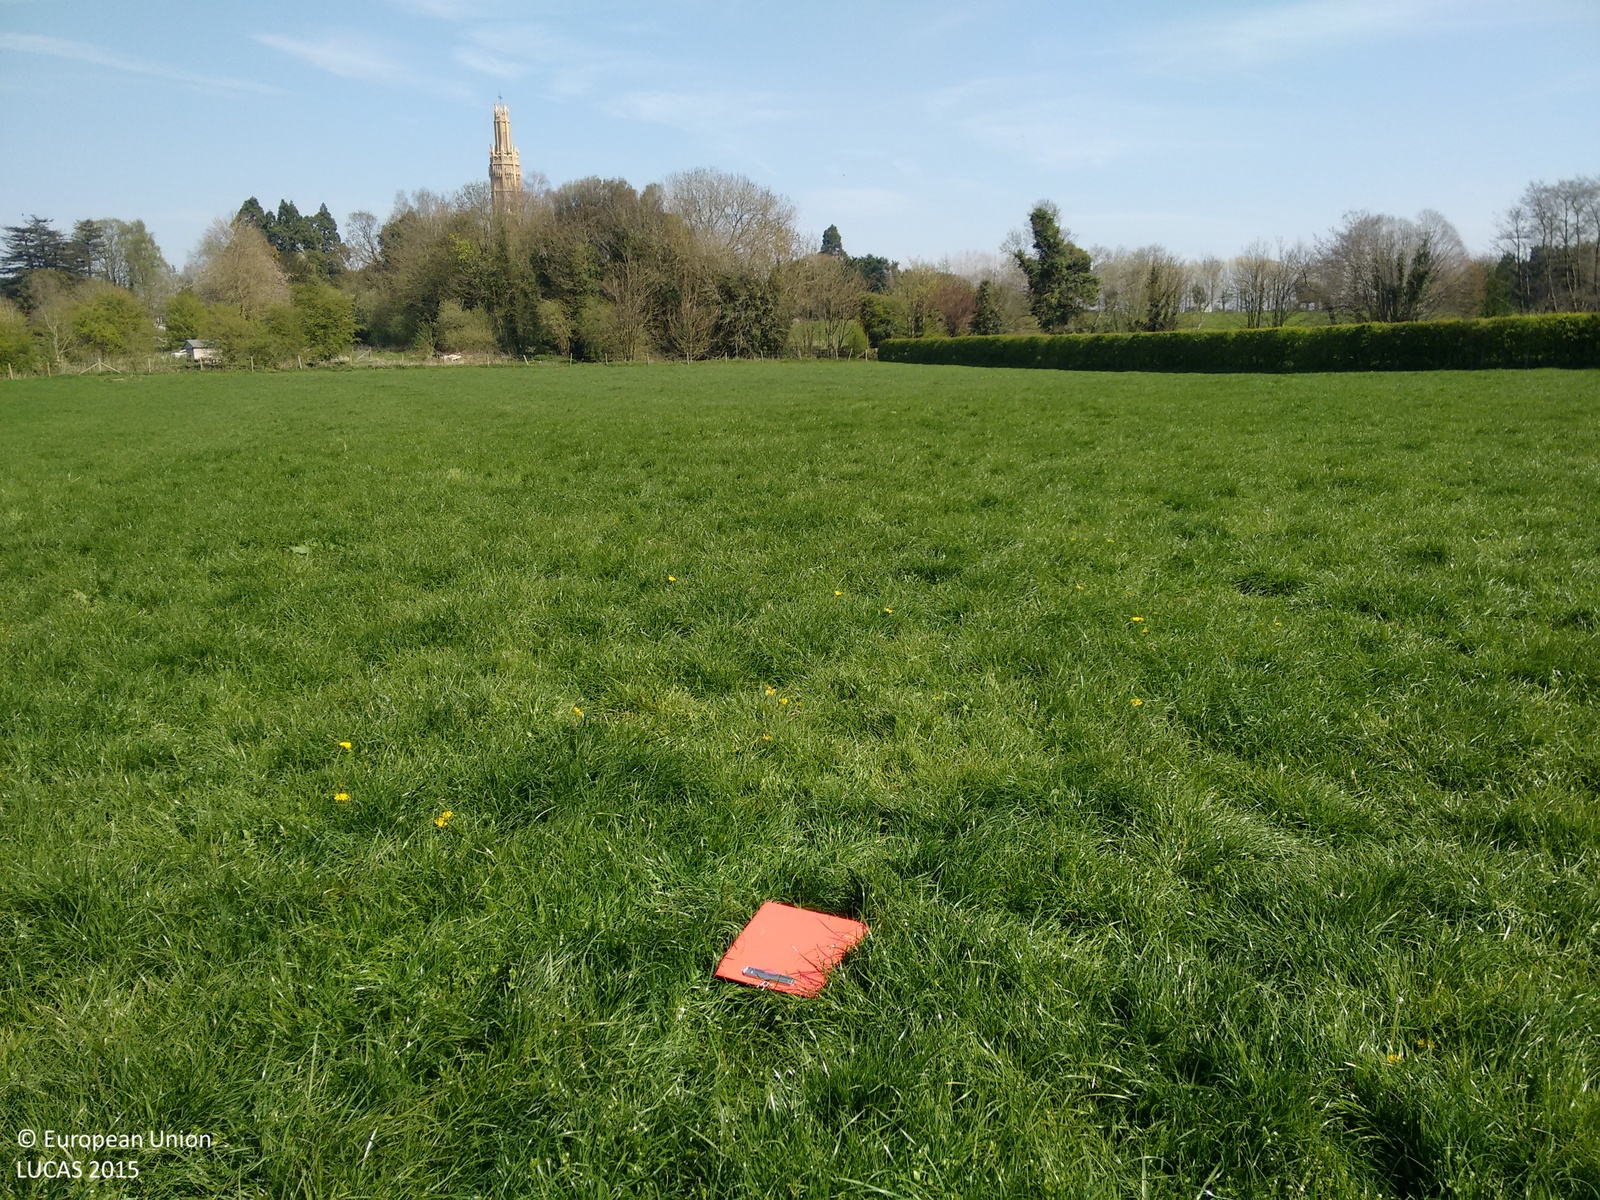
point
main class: Grassland
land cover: Grassland without tree/shrub cover
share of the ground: > 75 %
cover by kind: herbaceous plants 100 %
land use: Agriculture (excluding fallow land and kitchen gardens)
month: April
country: GB
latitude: 51.2216
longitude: 0.3344
